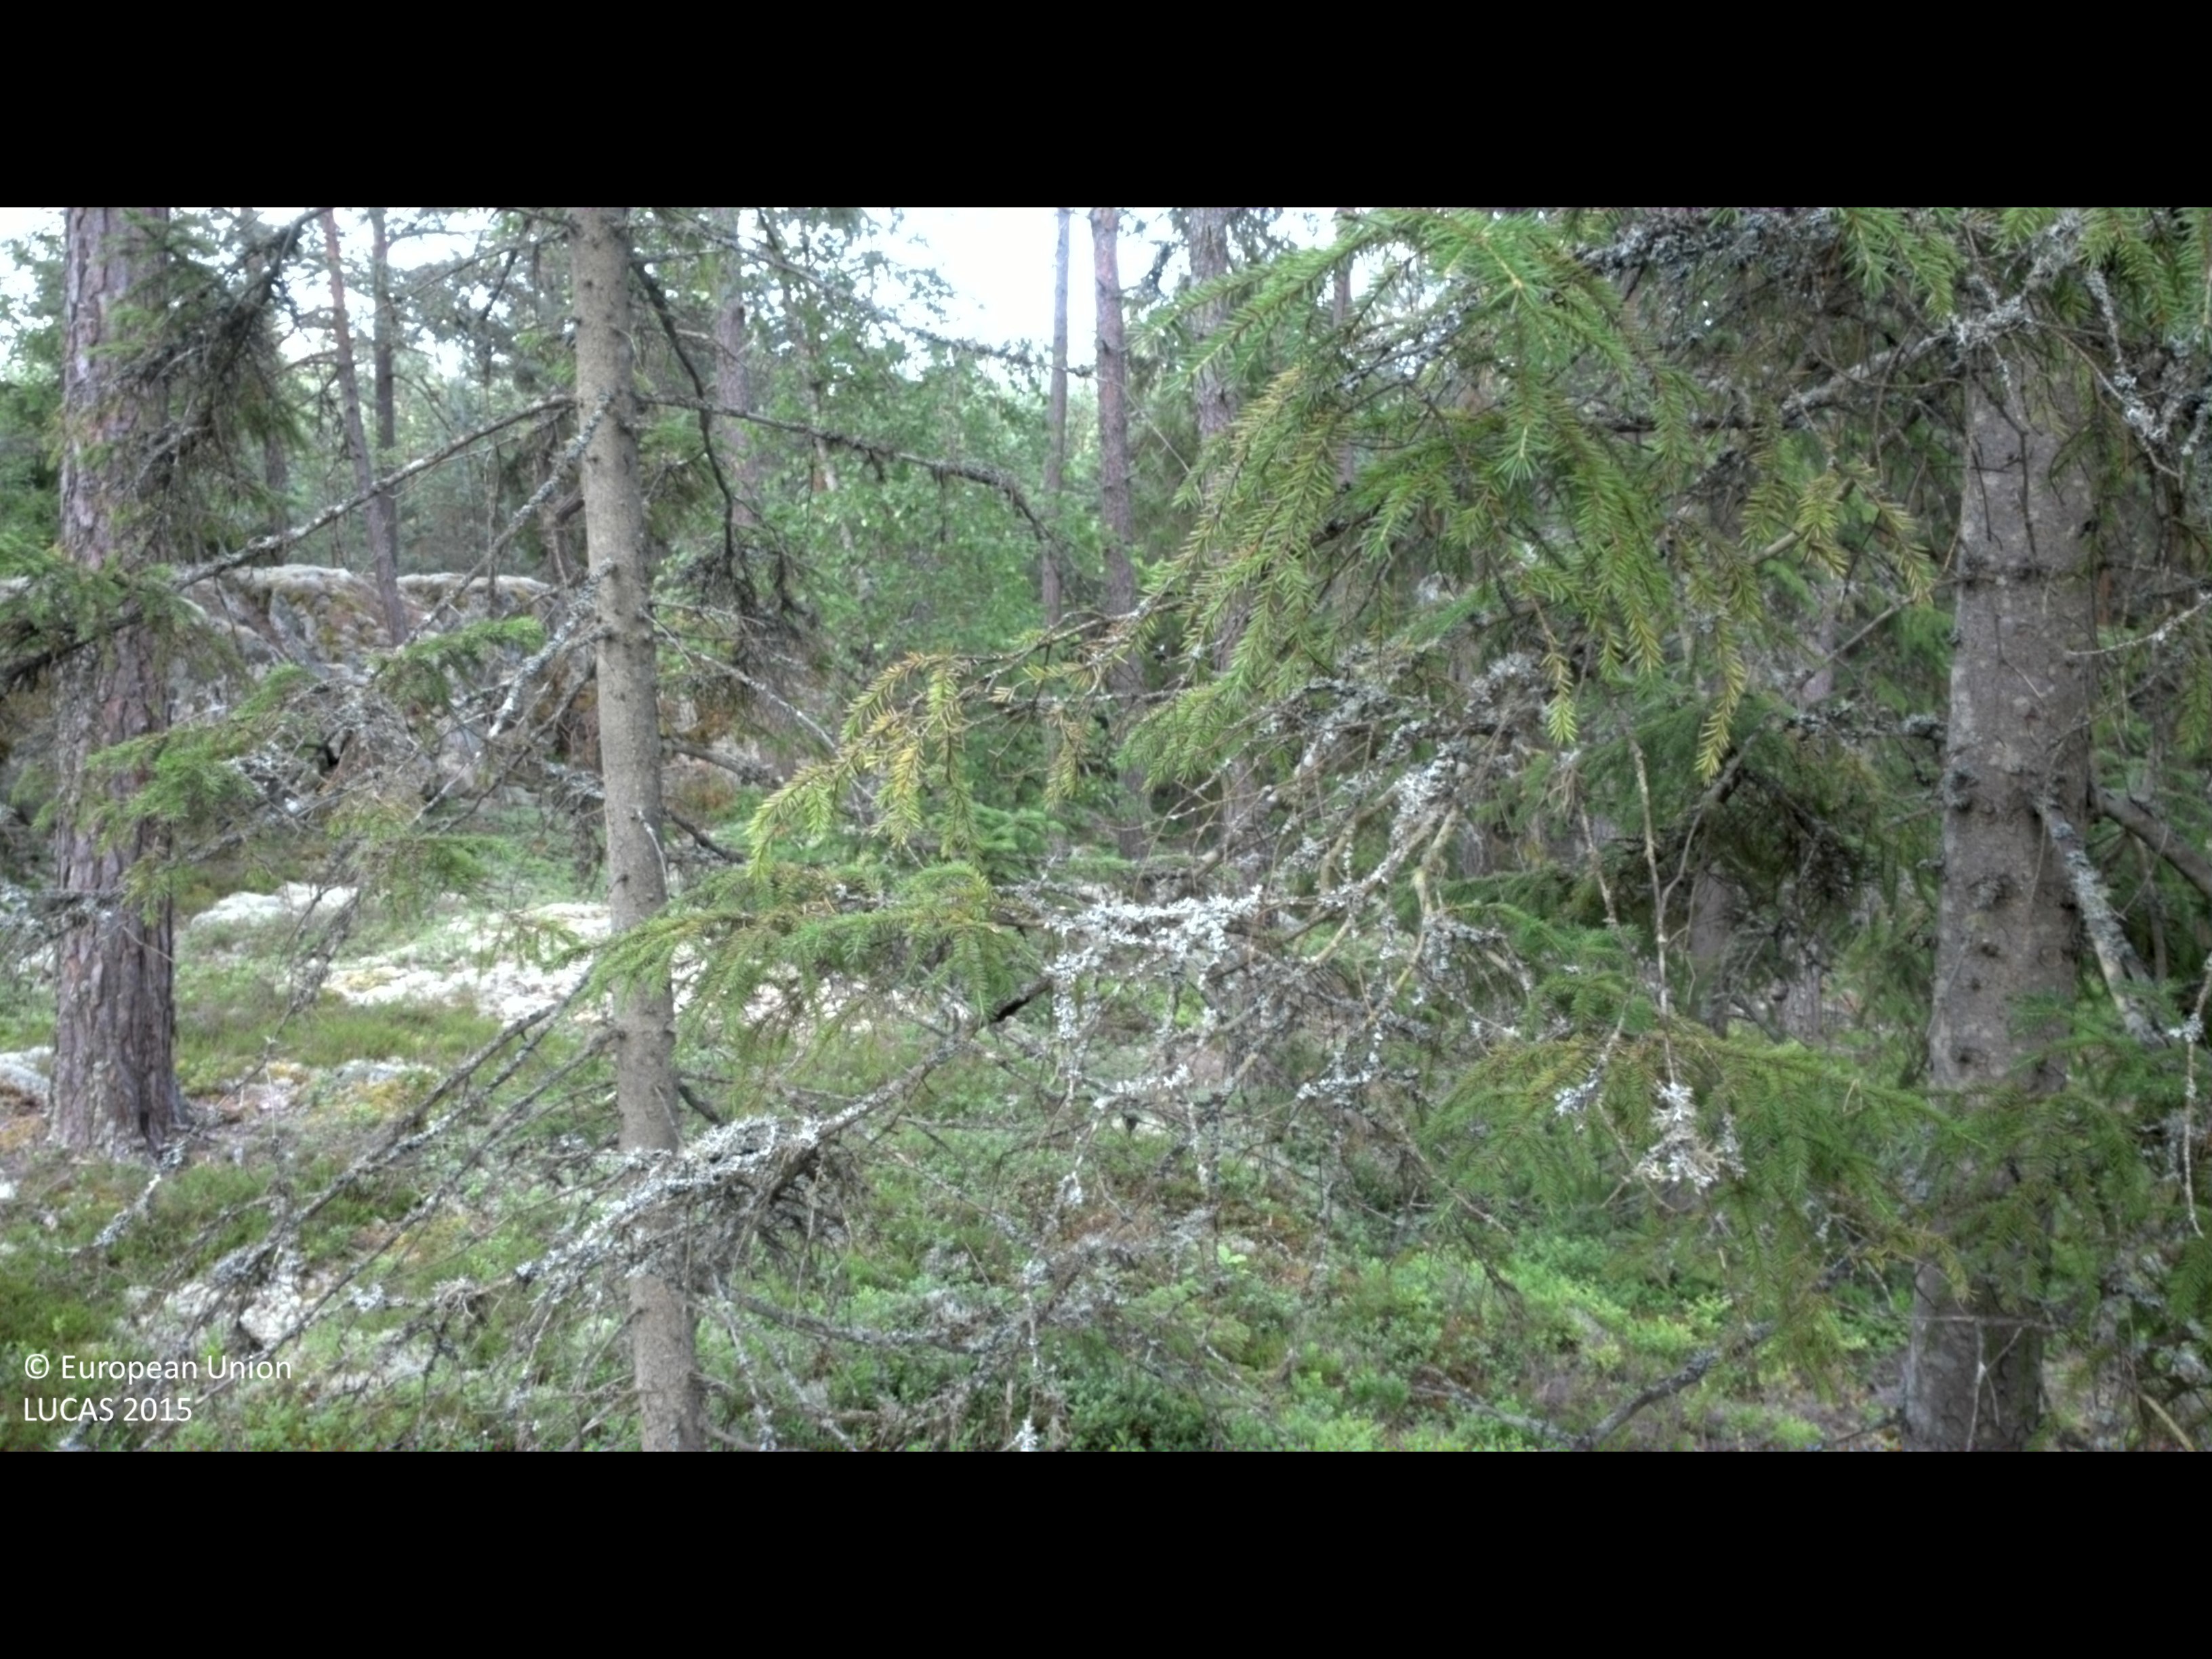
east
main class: Woodland
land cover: Pine dominated coniferous woodland
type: boreal forest
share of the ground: 50 - 75 %
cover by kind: coniferous forest trees 65 %, shrubs 20 %, lichens and mosses 15 %
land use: Forestry
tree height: > 5 m
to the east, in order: Pine dominated coniferous woodland; Other mixed woodland; Spruce dominated coniferous woodland; Broadleaved woodland; Spruce dominated mixed woodland; Rocks and stones
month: July
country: SE
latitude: 58.4041
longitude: 16.1390
